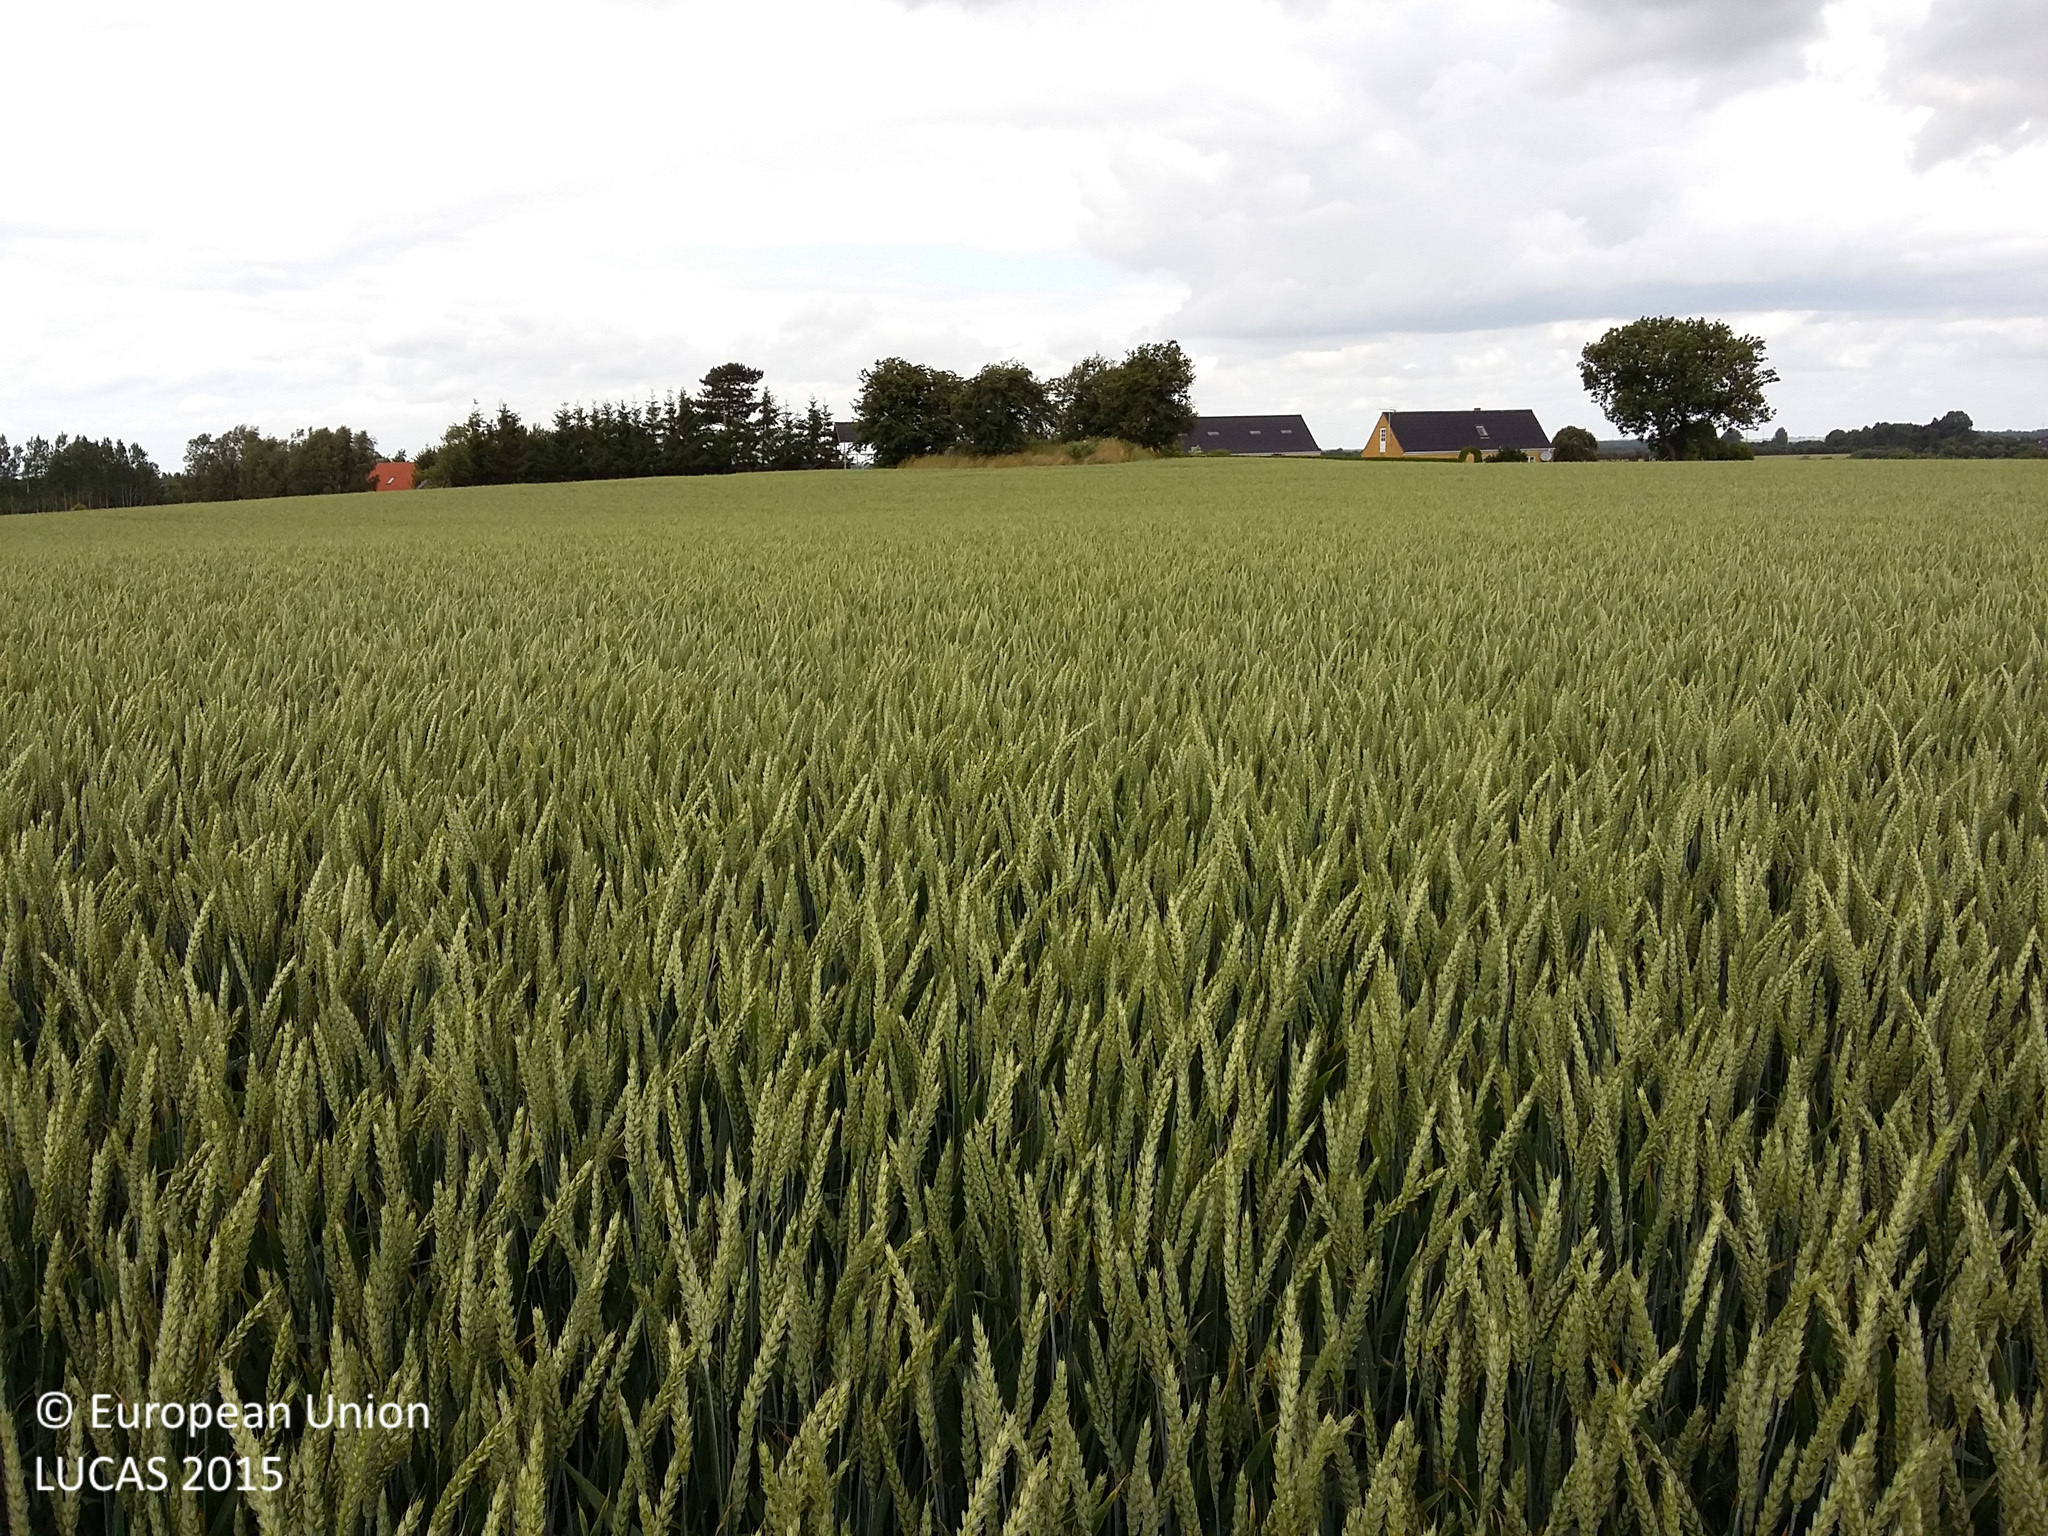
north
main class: Cropland
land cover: Common wheat
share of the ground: > 75 %
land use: Agriculture (excluding fallow land and kitchen gardens)
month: July
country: DK
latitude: 55.4224
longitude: 11.6260
